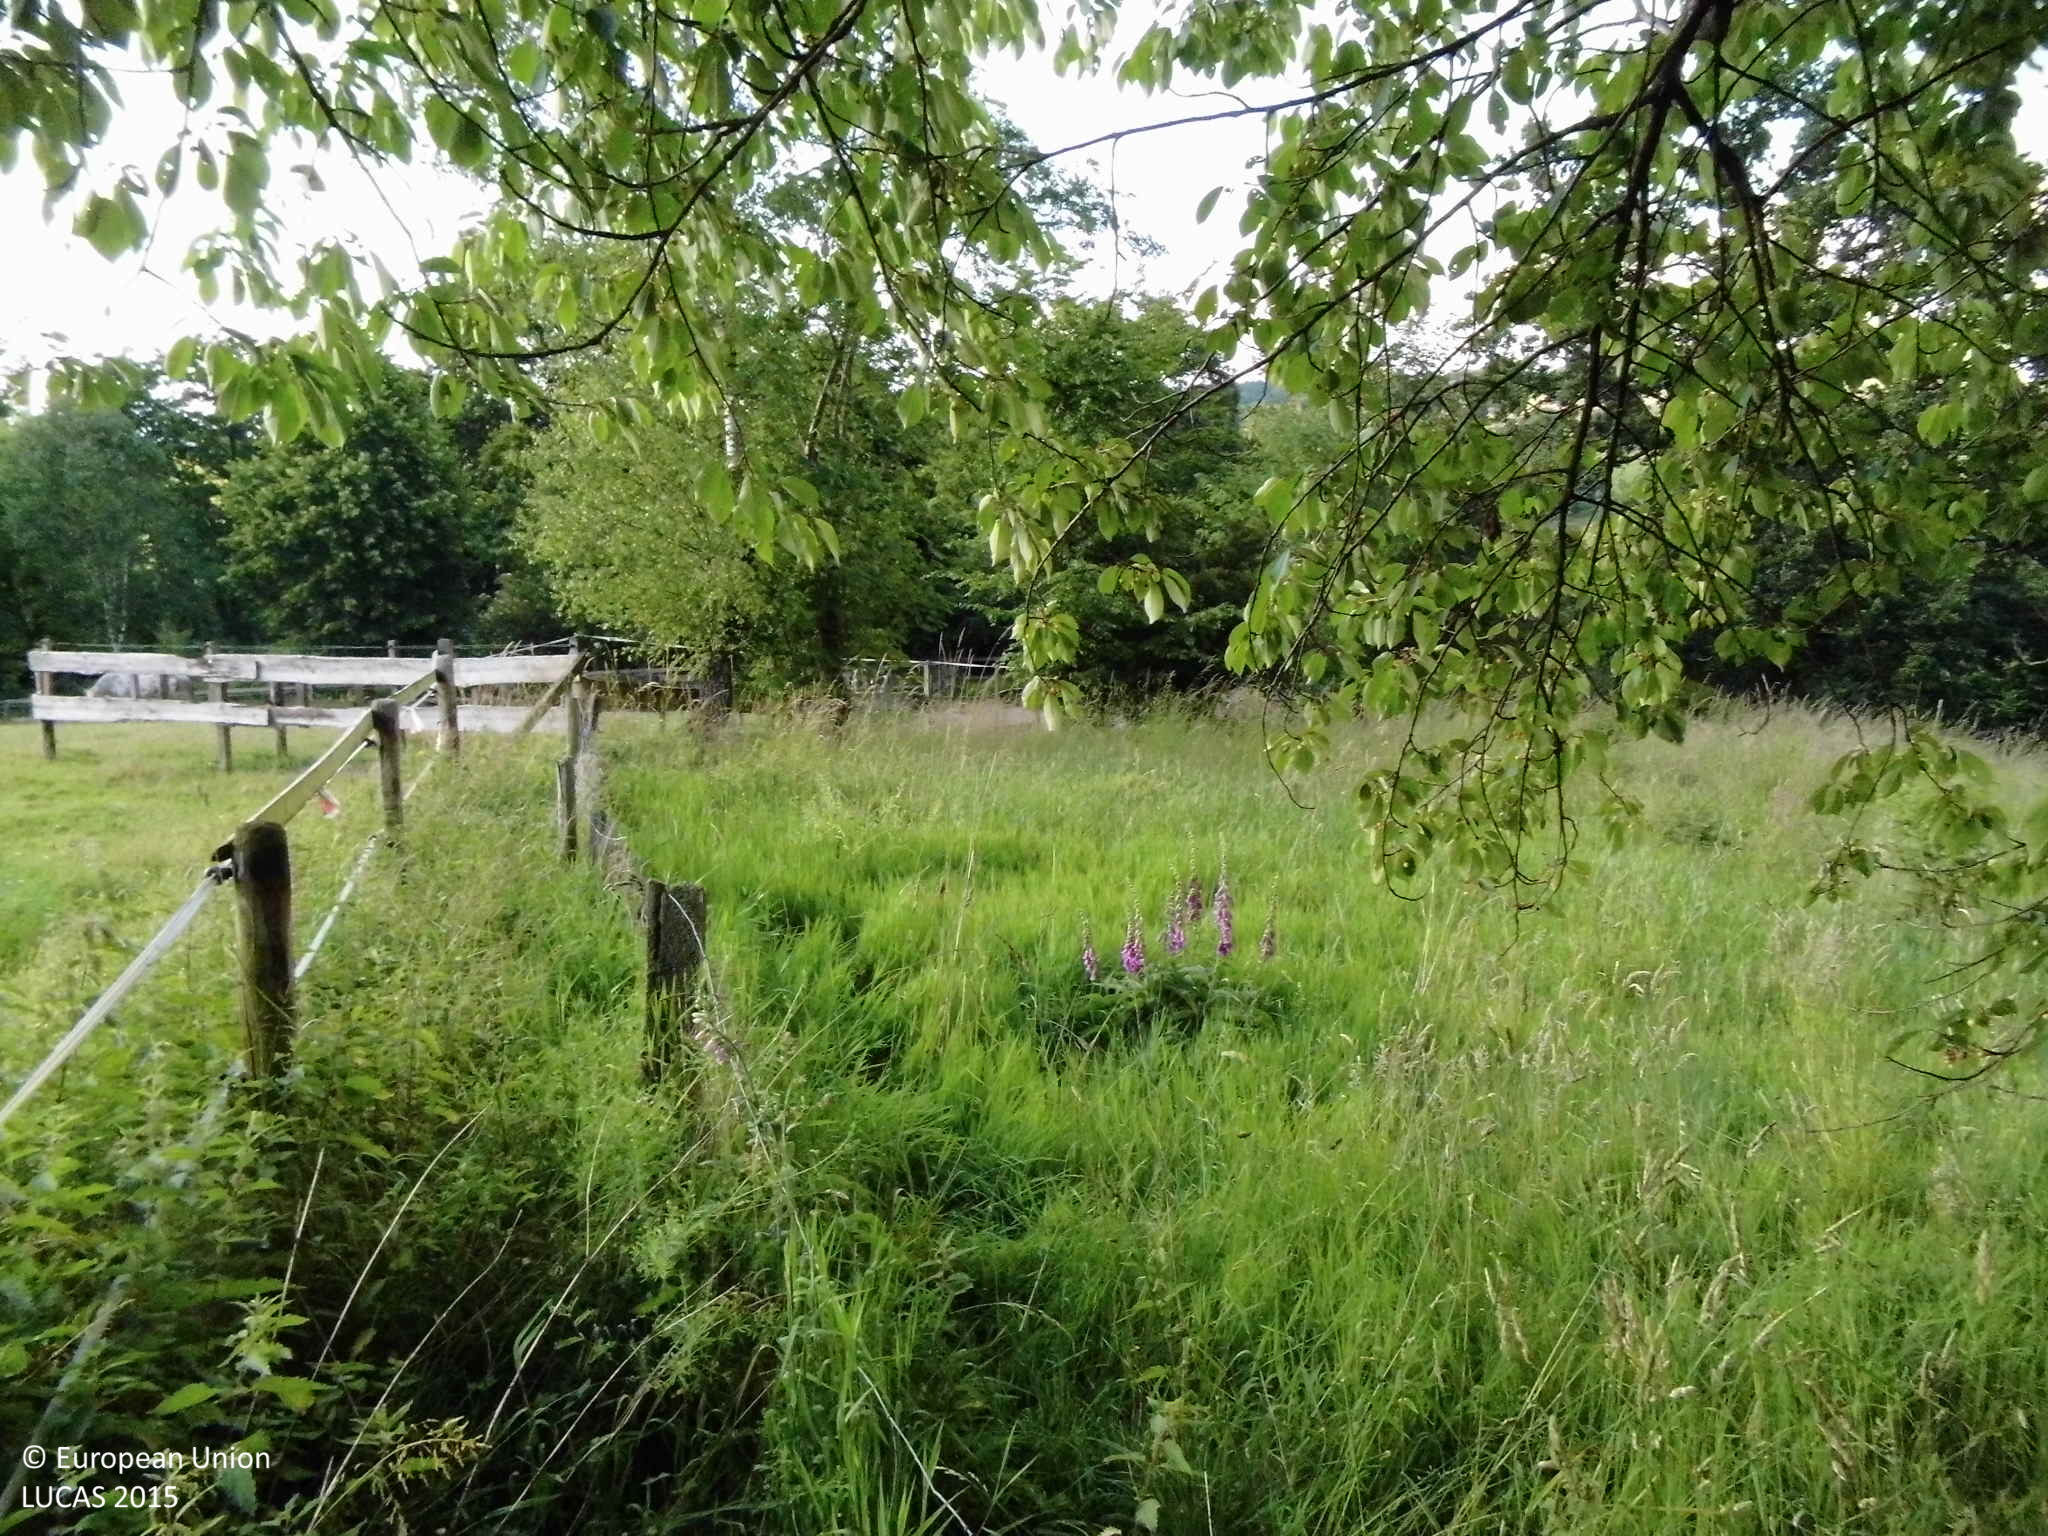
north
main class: Grassland
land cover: Grassland without tree/shrub cover
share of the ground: > 75 %
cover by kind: herbaceous plants 100 %
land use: Agriculture (excluding fallow land and kitchen gardens)
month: June
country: DE
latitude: 50.8773
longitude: 7.5415
